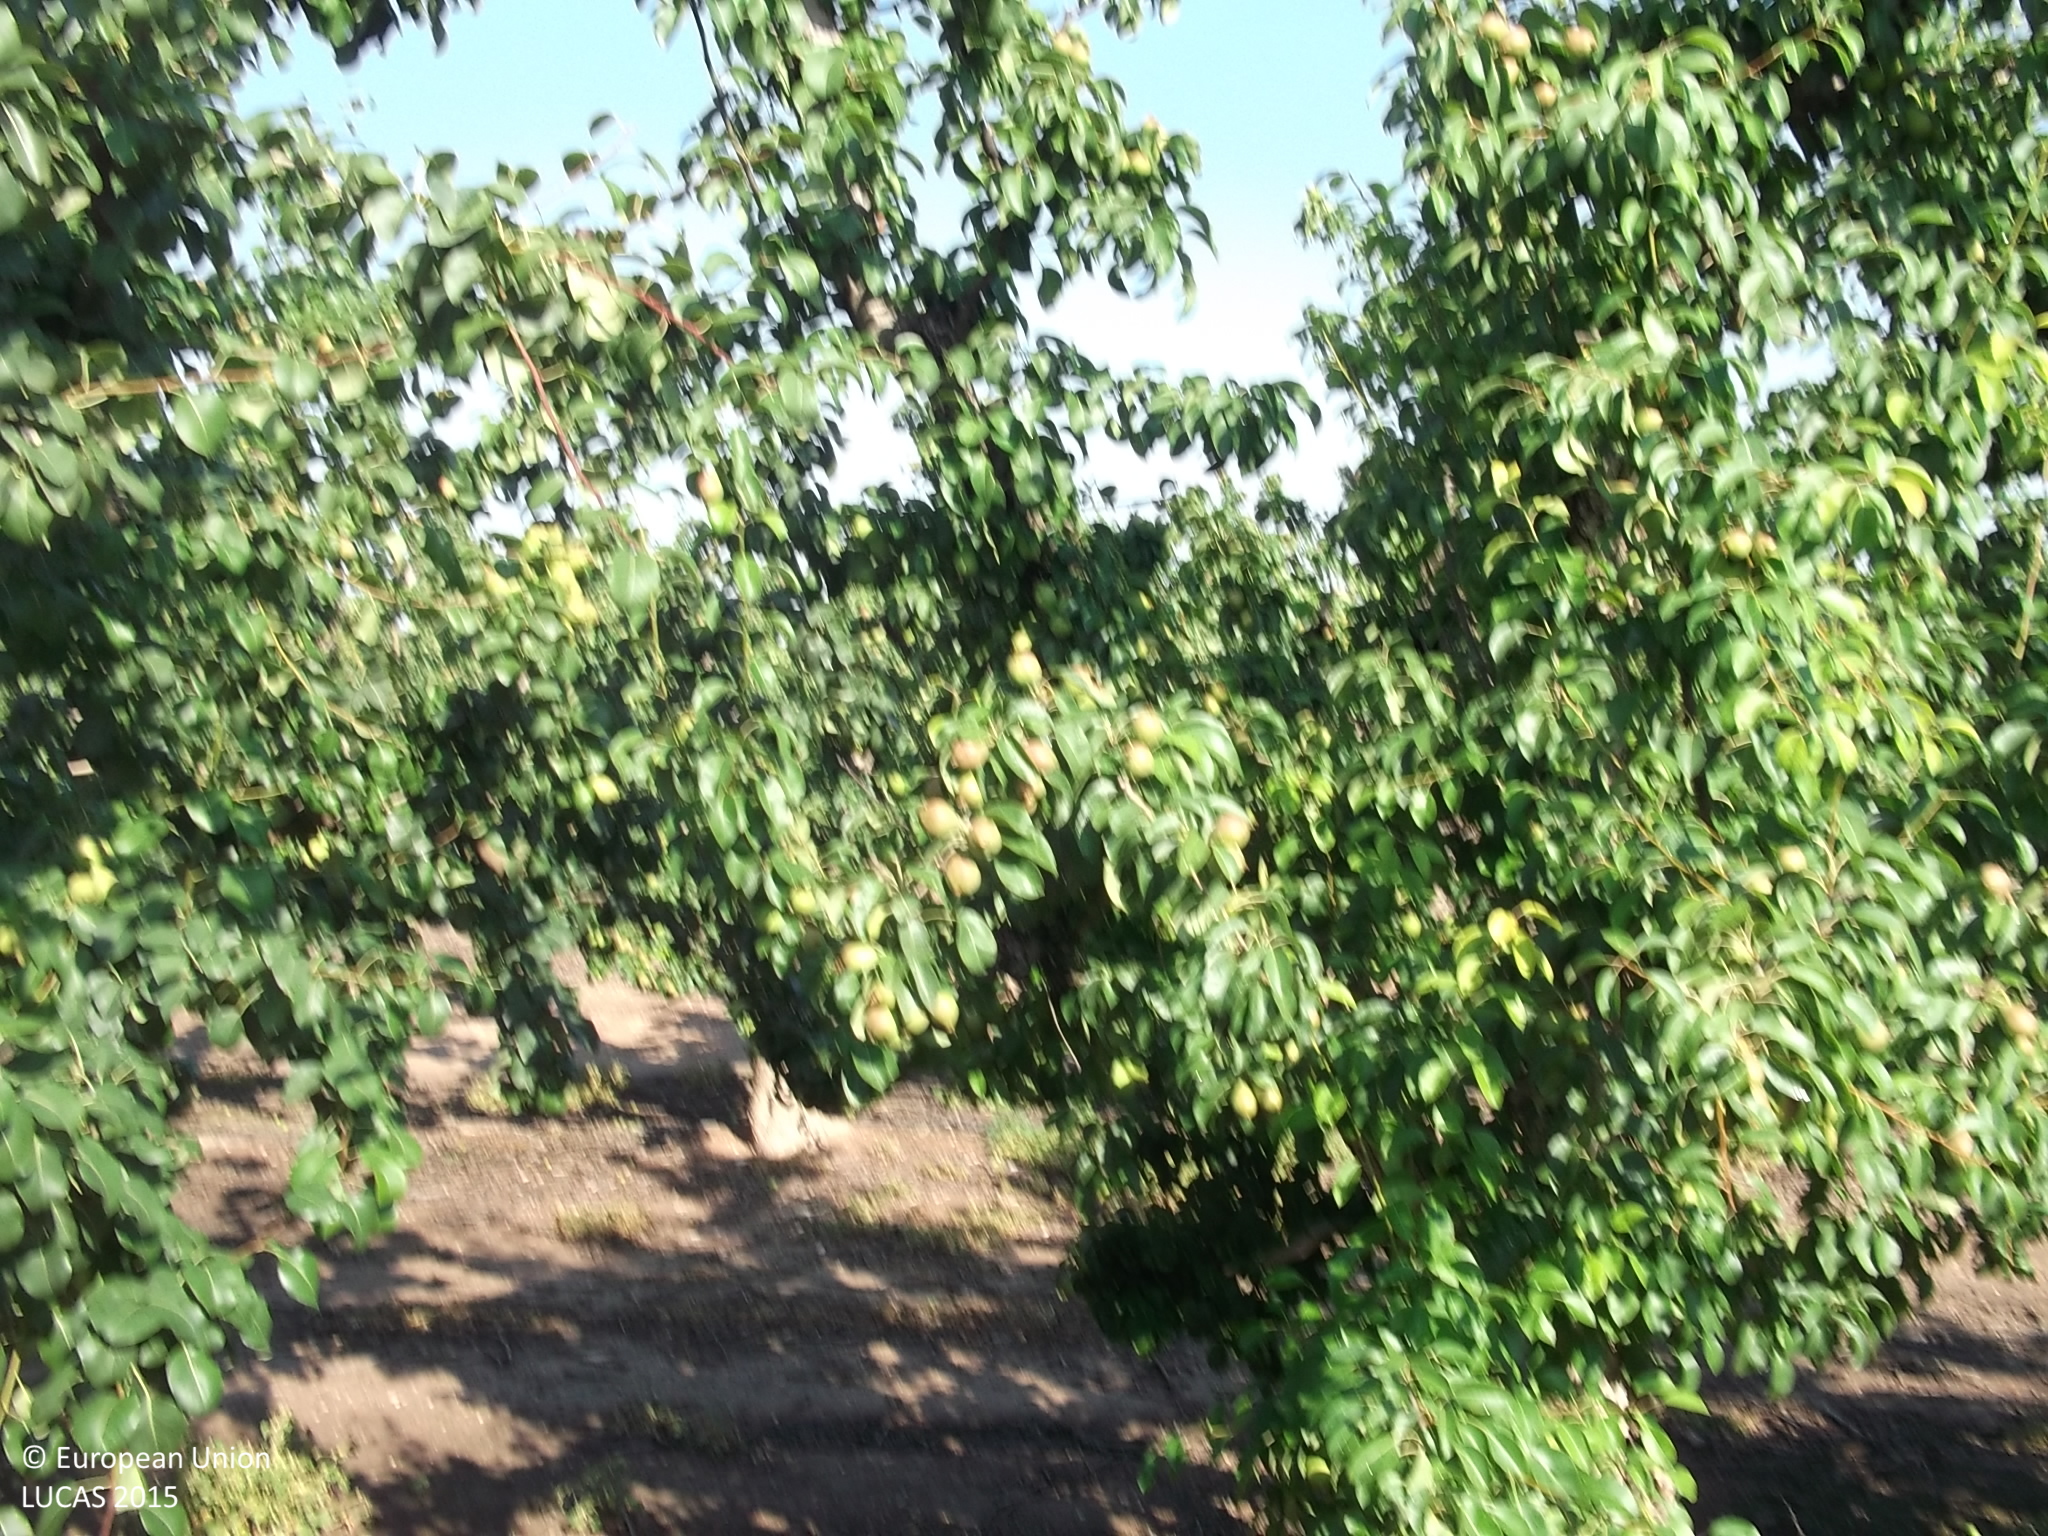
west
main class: Cropland
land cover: Pear fruit
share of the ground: 25 - 50 %
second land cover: Other bare soil
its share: > 75 %
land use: Agriculture (excluding fallow land and kitchen gardens)
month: June
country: ES
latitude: 38.4560
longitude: -1.3469
